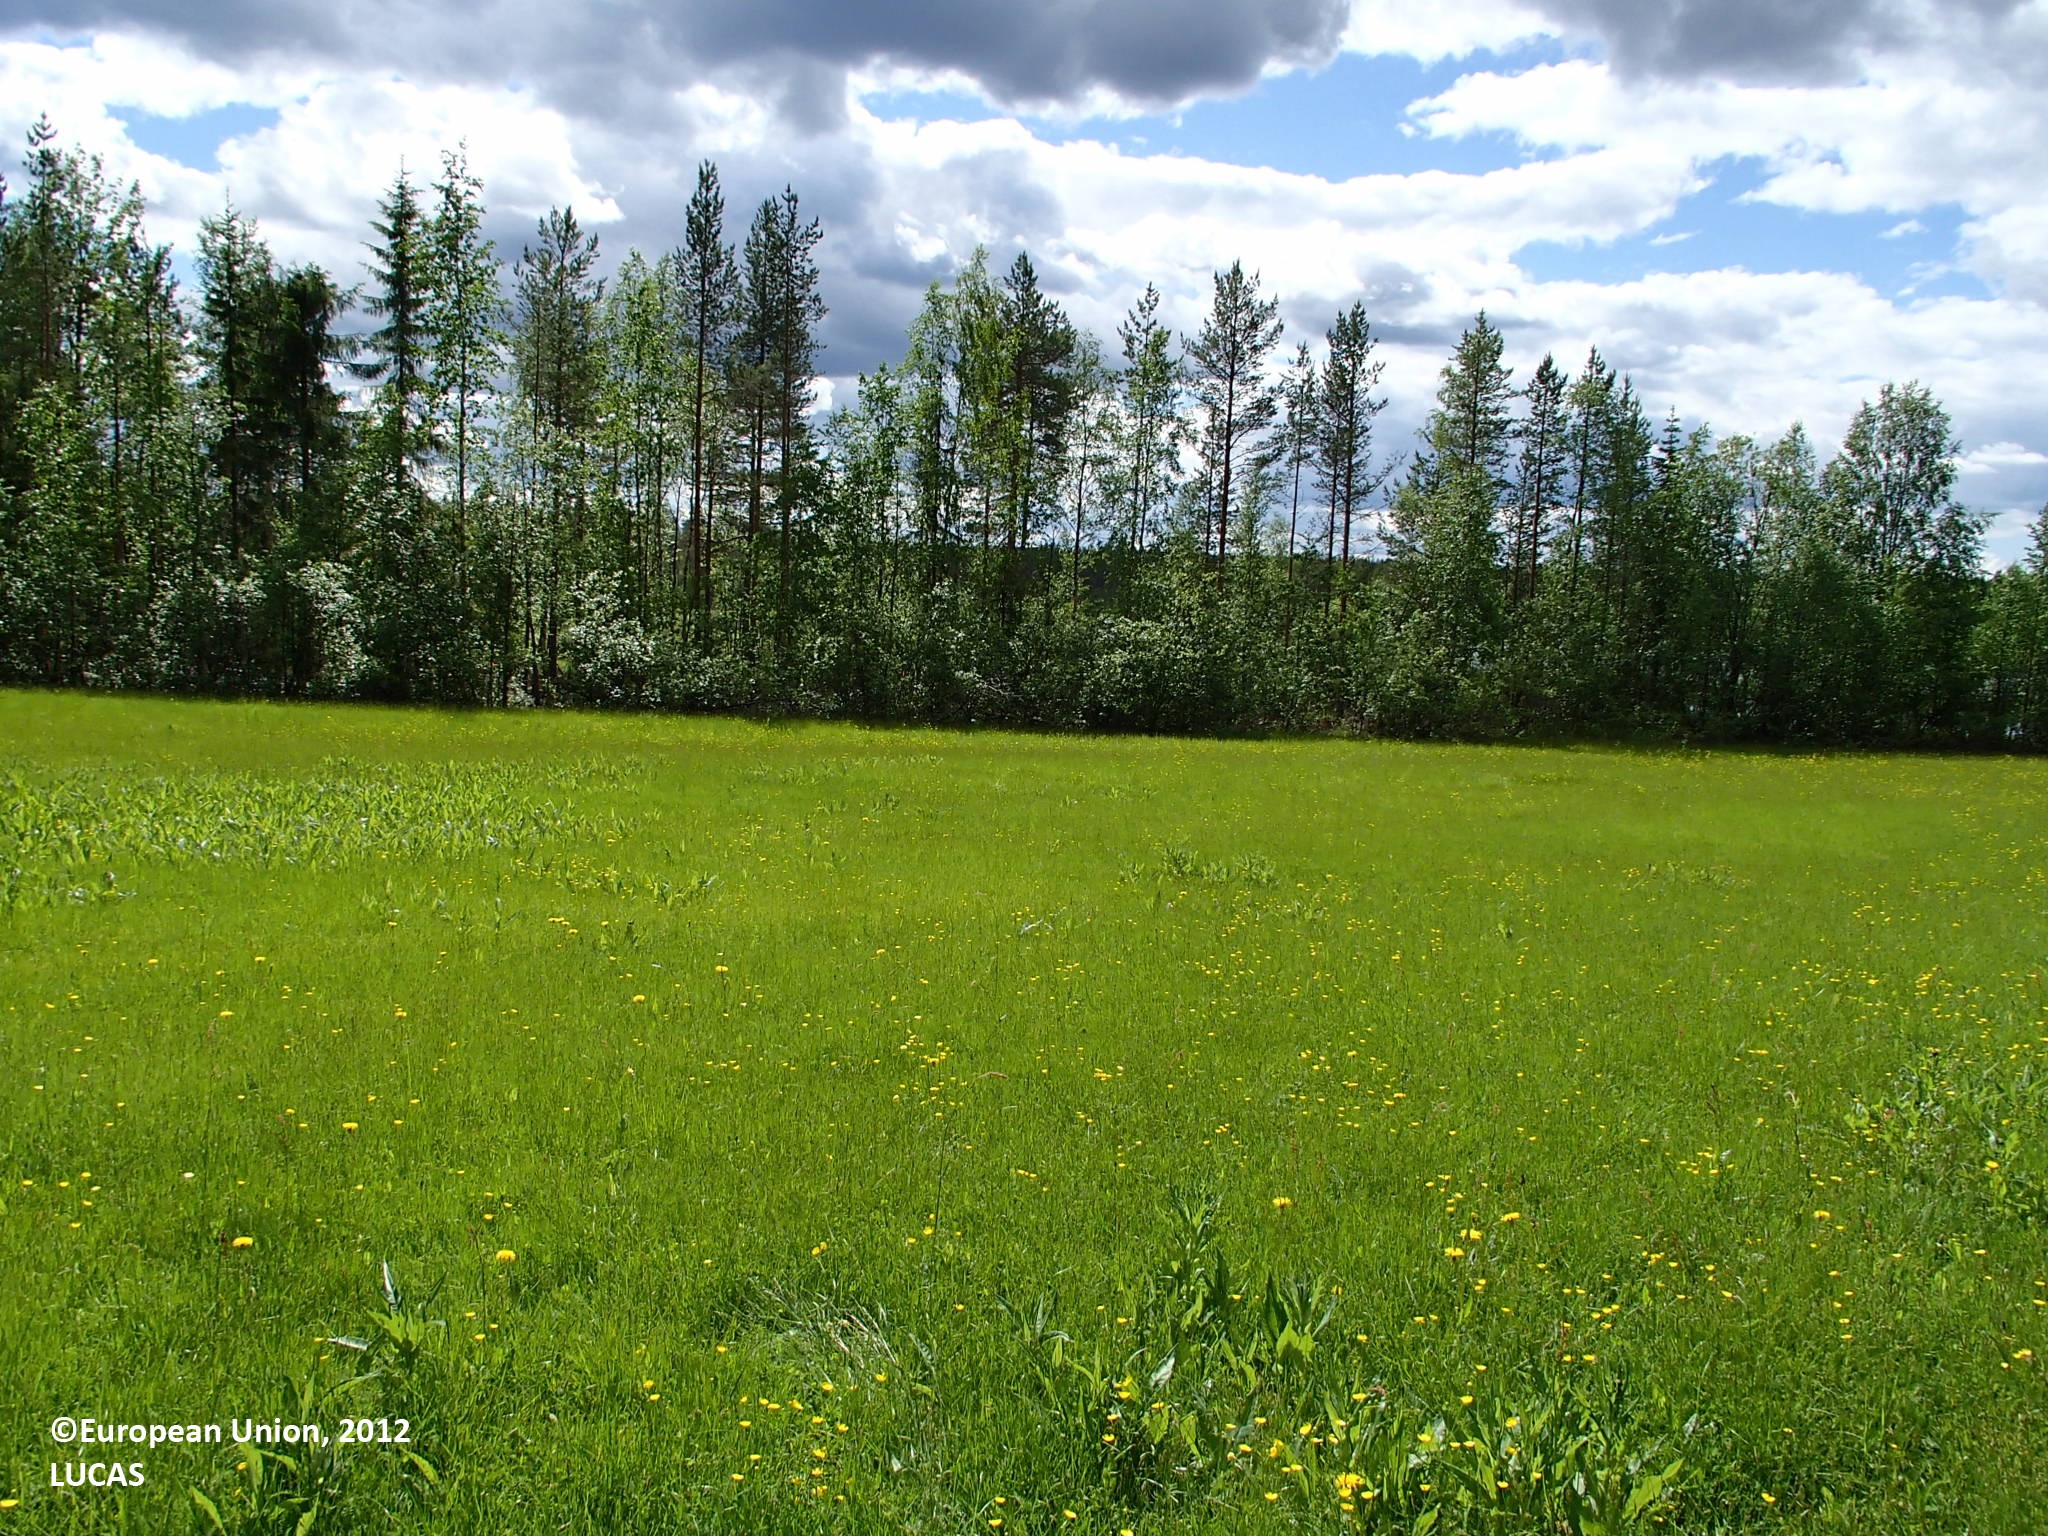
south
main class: Grassland
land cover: Grassland without tree/shrub cover
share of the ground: > 75 %
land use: Agriculture (excluding fallow land and kitchen gardens)
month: June
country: FI
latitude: 66.5173
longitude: 27.2205
